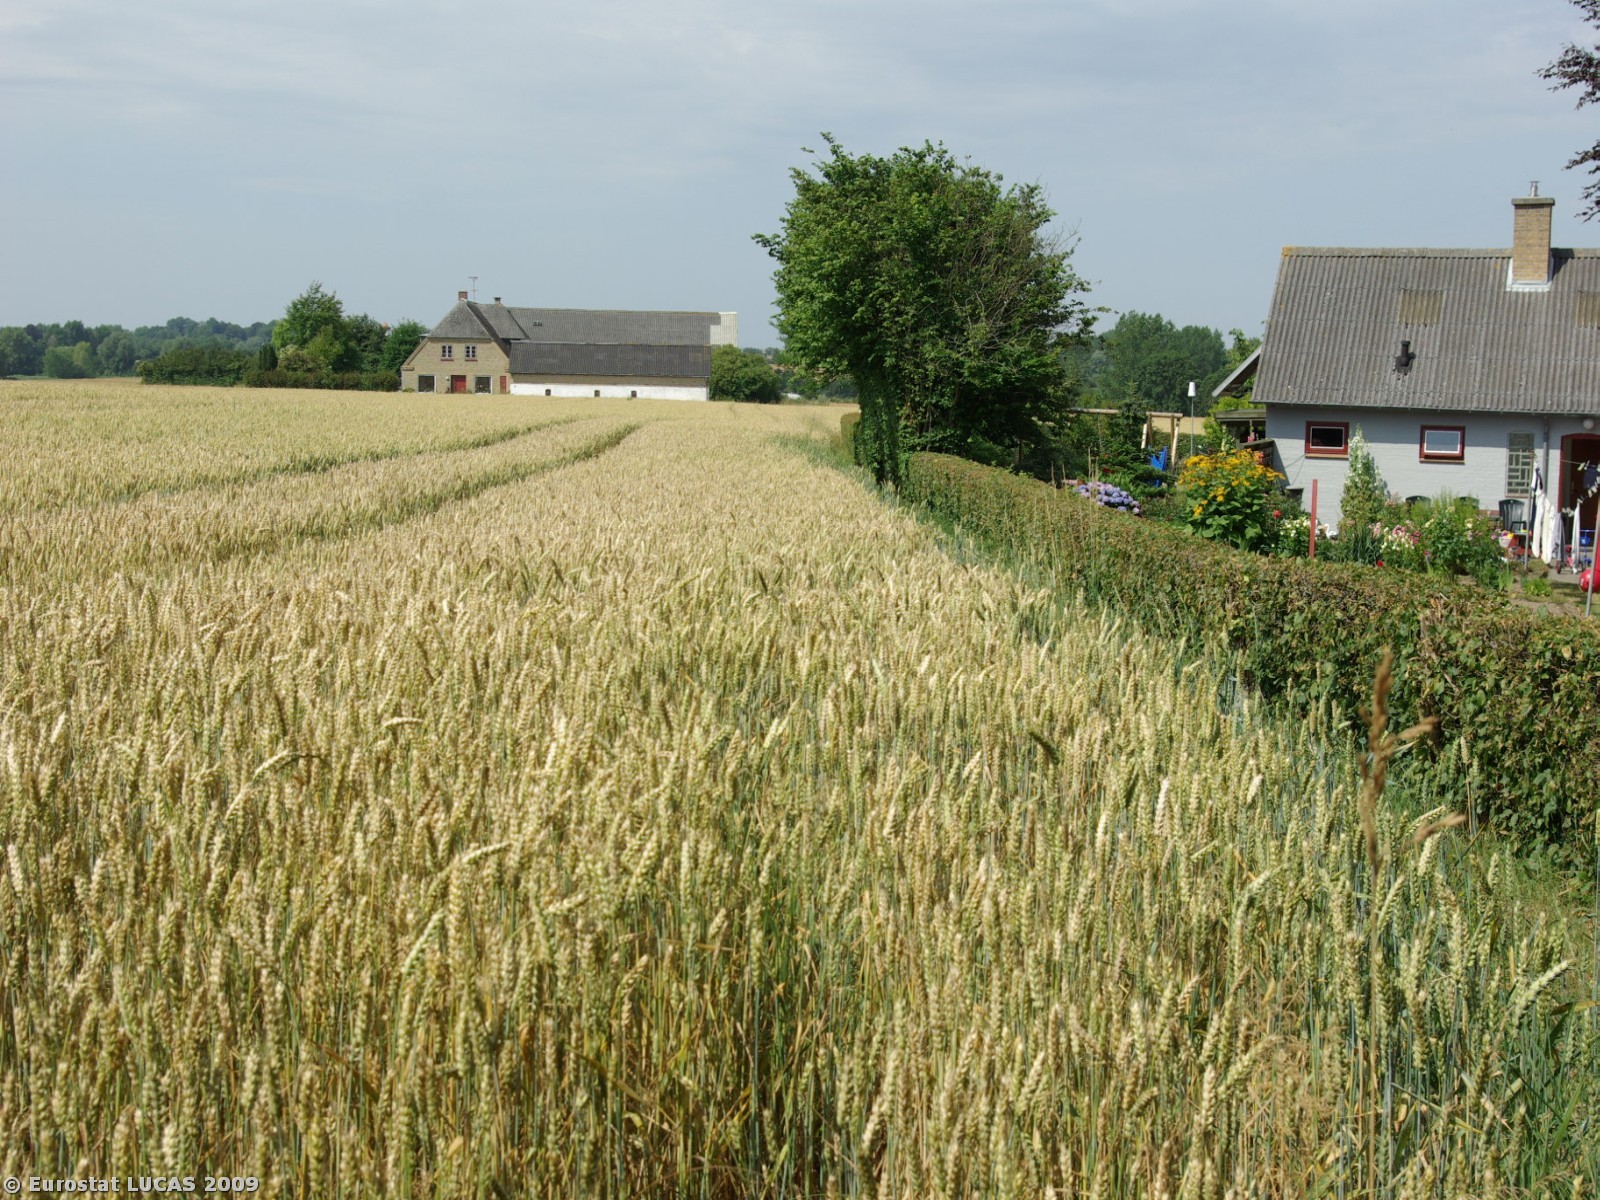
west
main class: Cropland
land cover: Common wheat
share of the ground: > 75 %
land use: Agriculture (excluding fallow land and kitchen gardens)
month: July
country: DK
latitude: 54.8756
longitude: 9.9221
